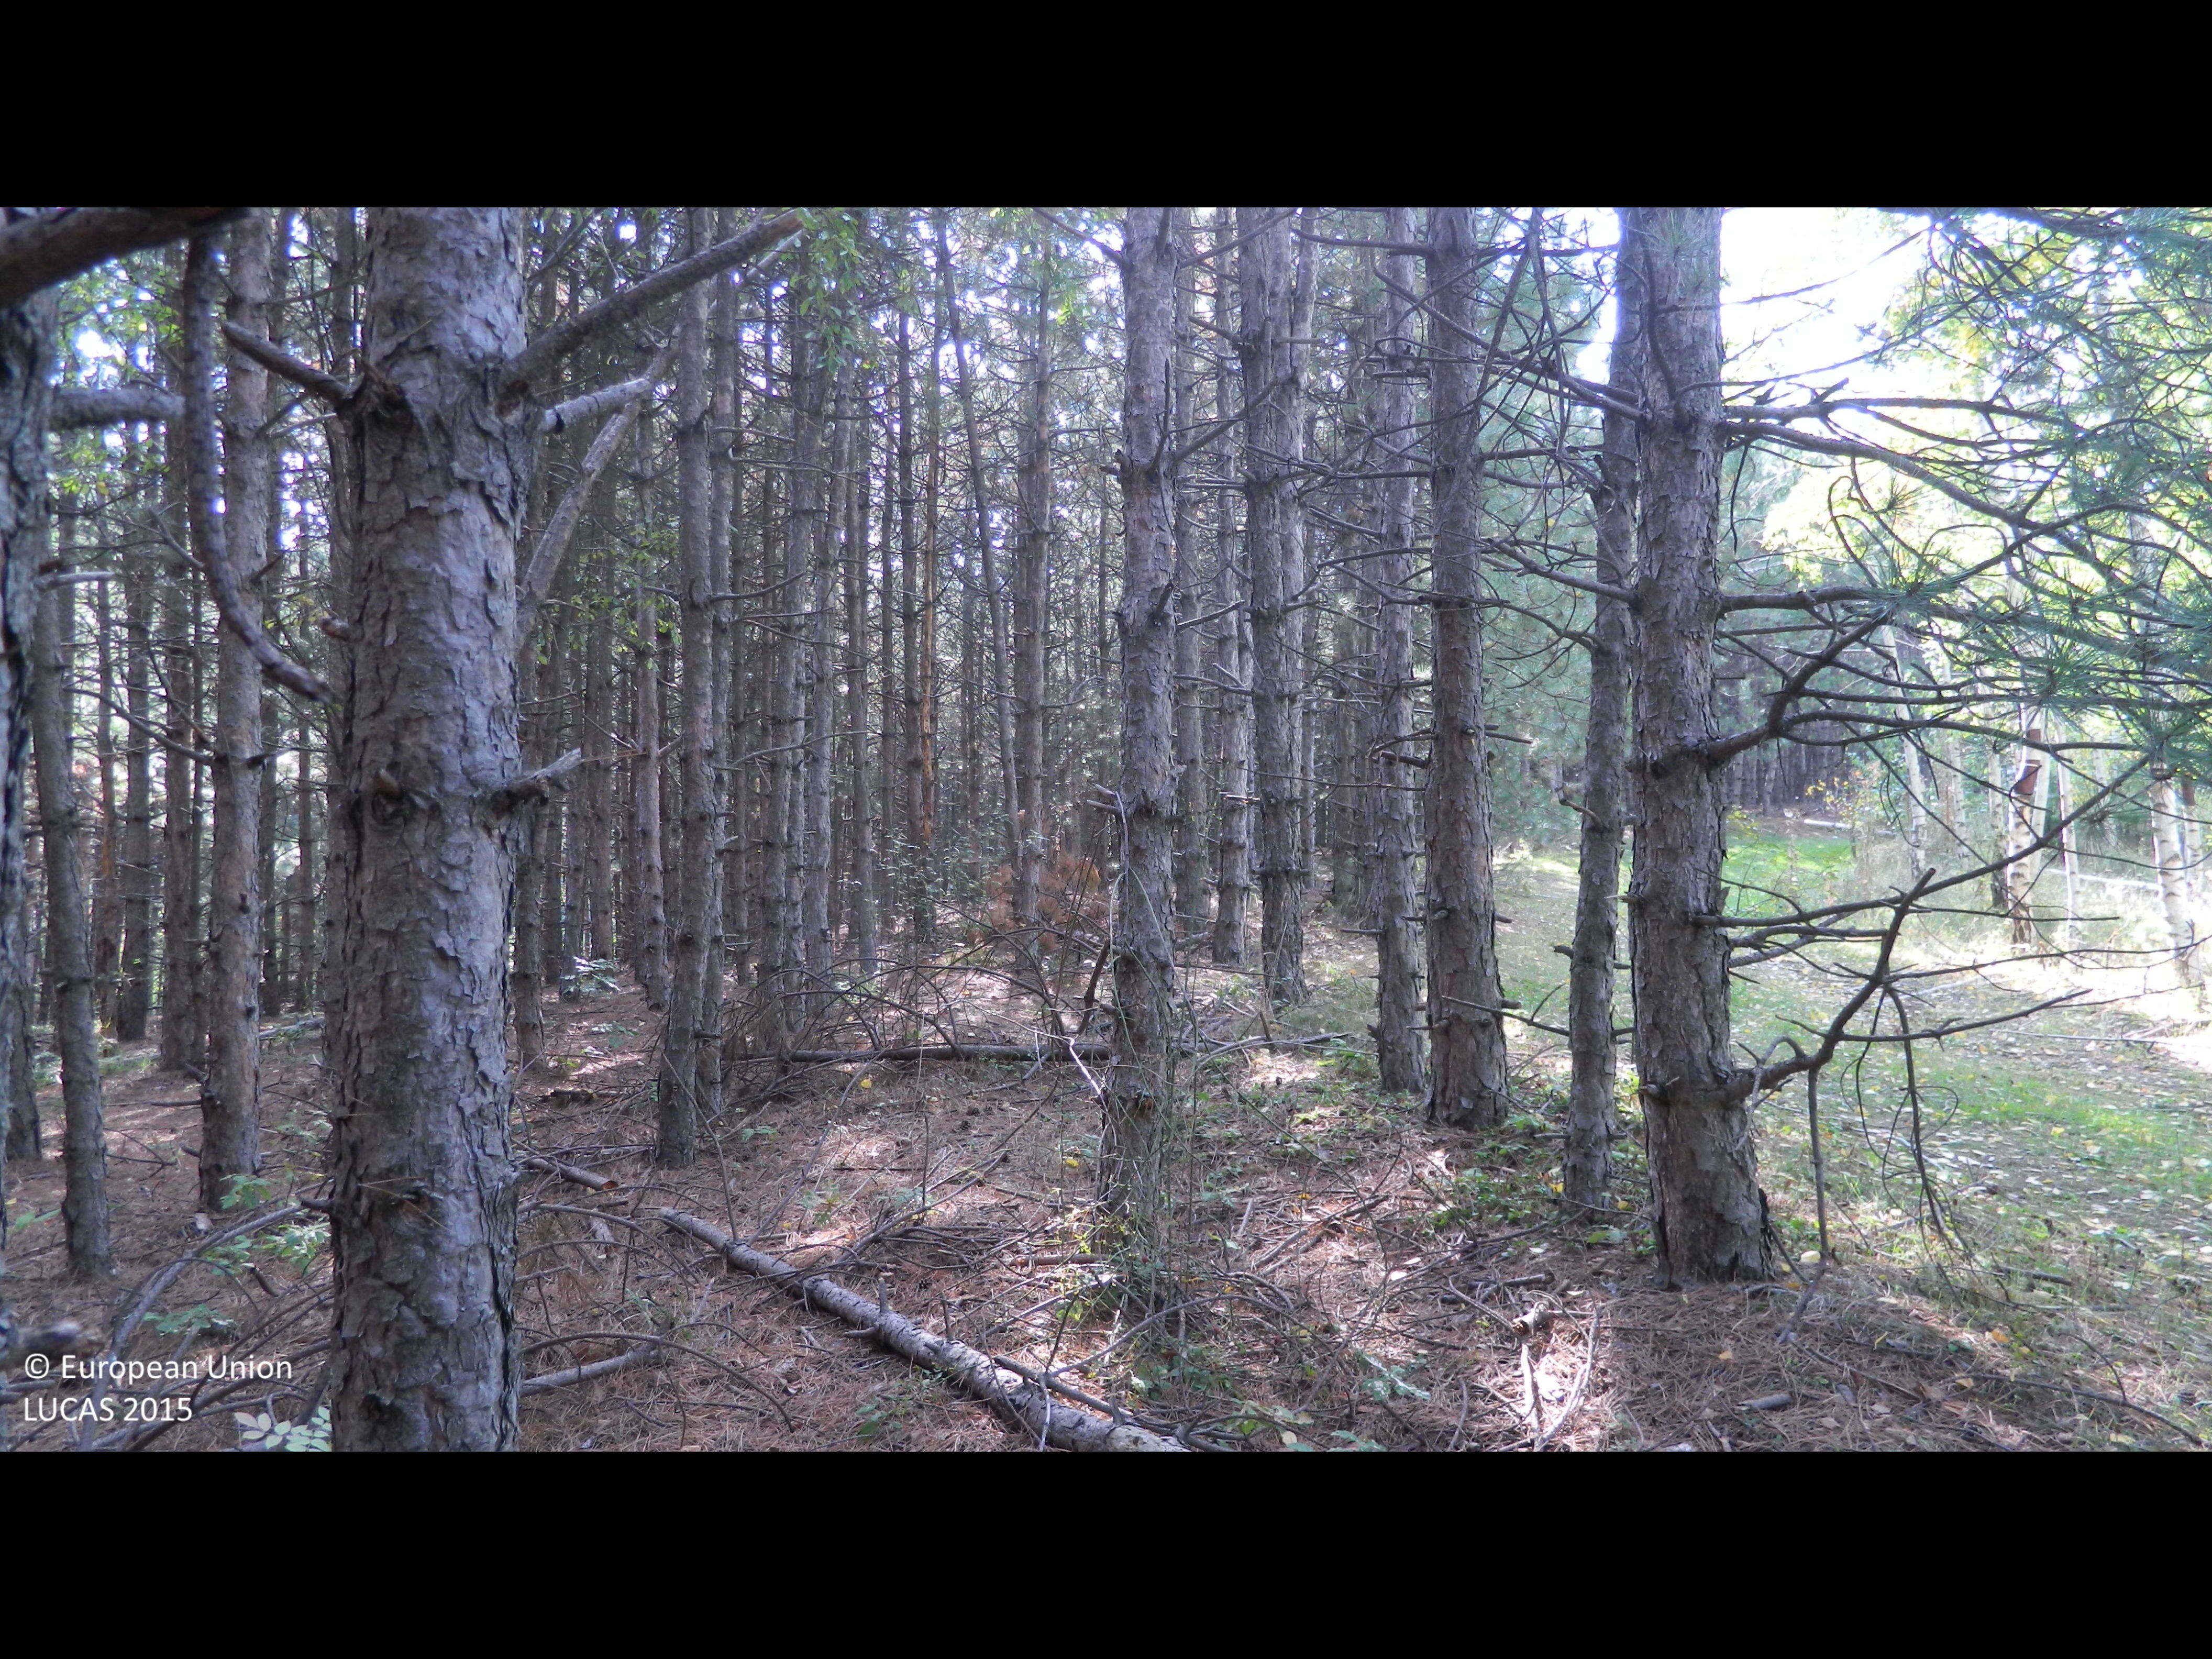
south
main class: Woodland
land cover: Pine dominated coniferous woodland
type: hemiboreal forest and nemoral coniferous forest and mixed broadleaved-coniferous forest
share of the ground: > 75 %
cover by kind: coniferous forest trees 95 %, broadleaved forest trees 5 %
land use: Forestry
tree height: > 5 m
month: October
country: BG
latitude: 41.7948
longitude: 25.3049
